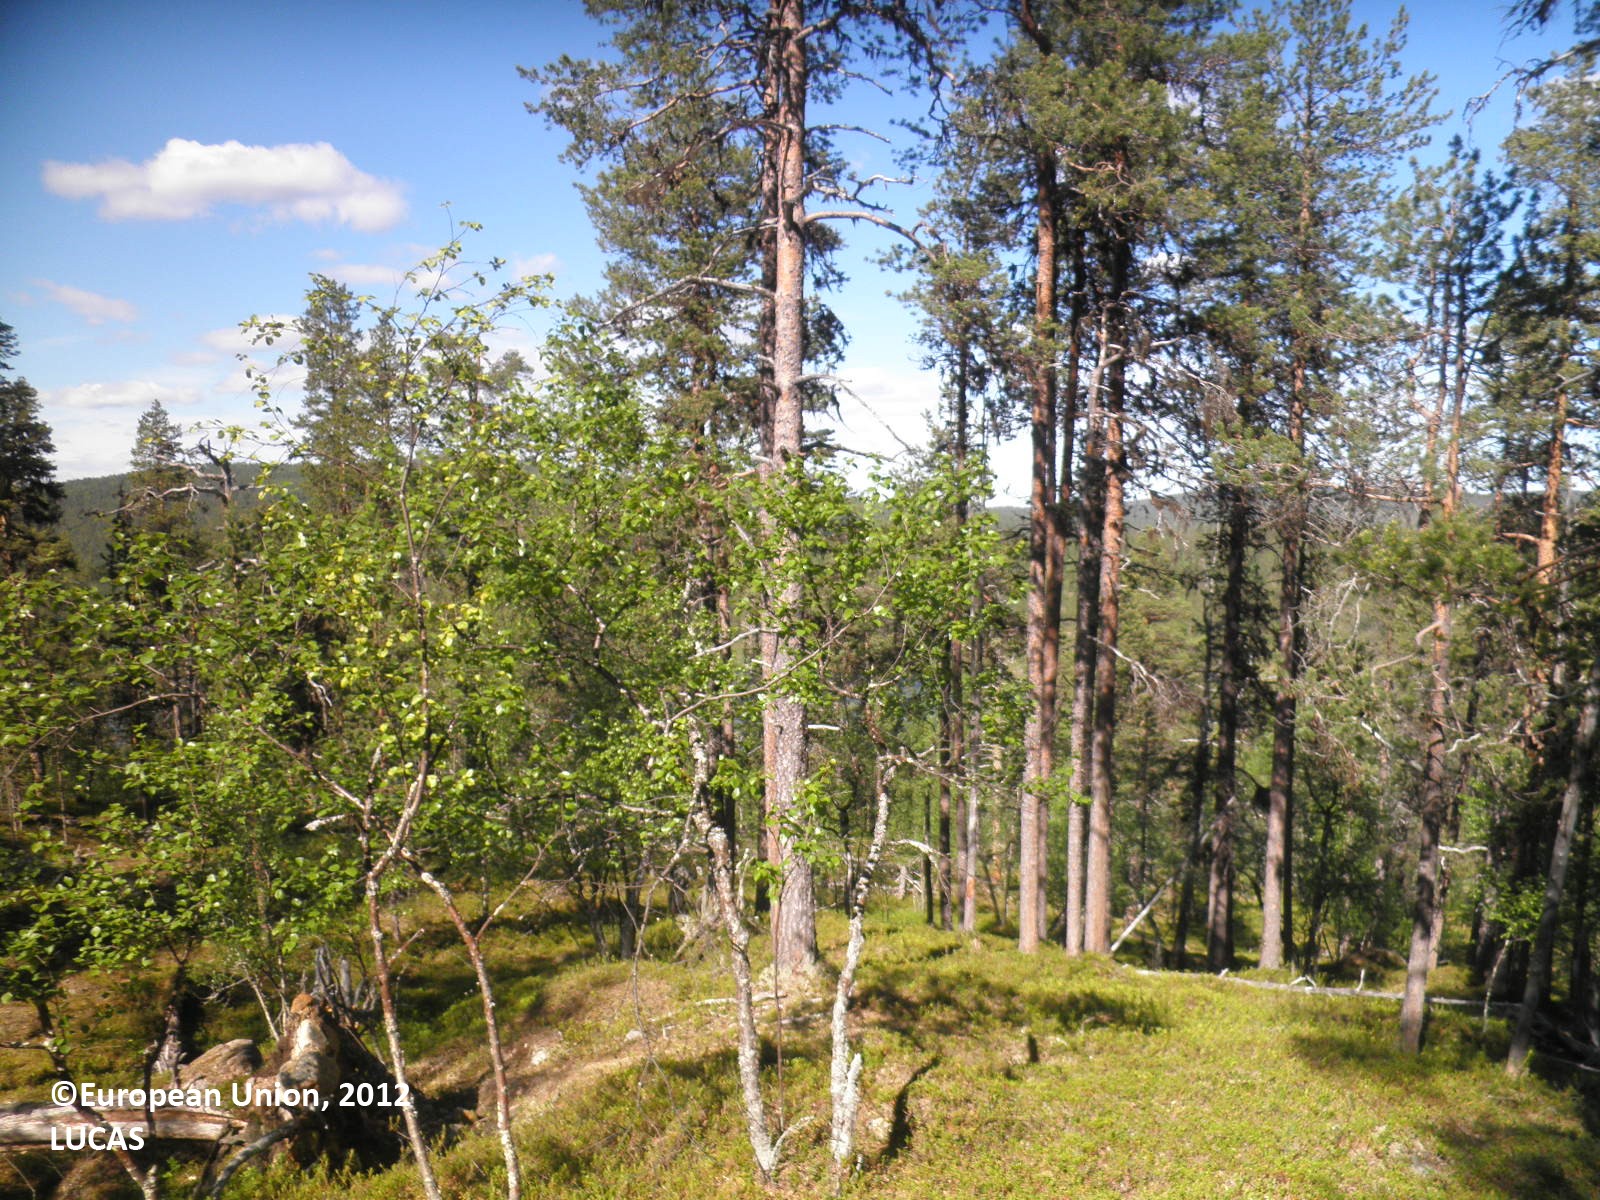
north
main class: Woodland
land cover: Pine dominated mixed woodland
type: boreal forest
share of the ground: 50 - 75 %
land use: Forestry
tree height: > 5 m
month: July
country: FI
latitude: 68.7795
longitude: 27.0200
